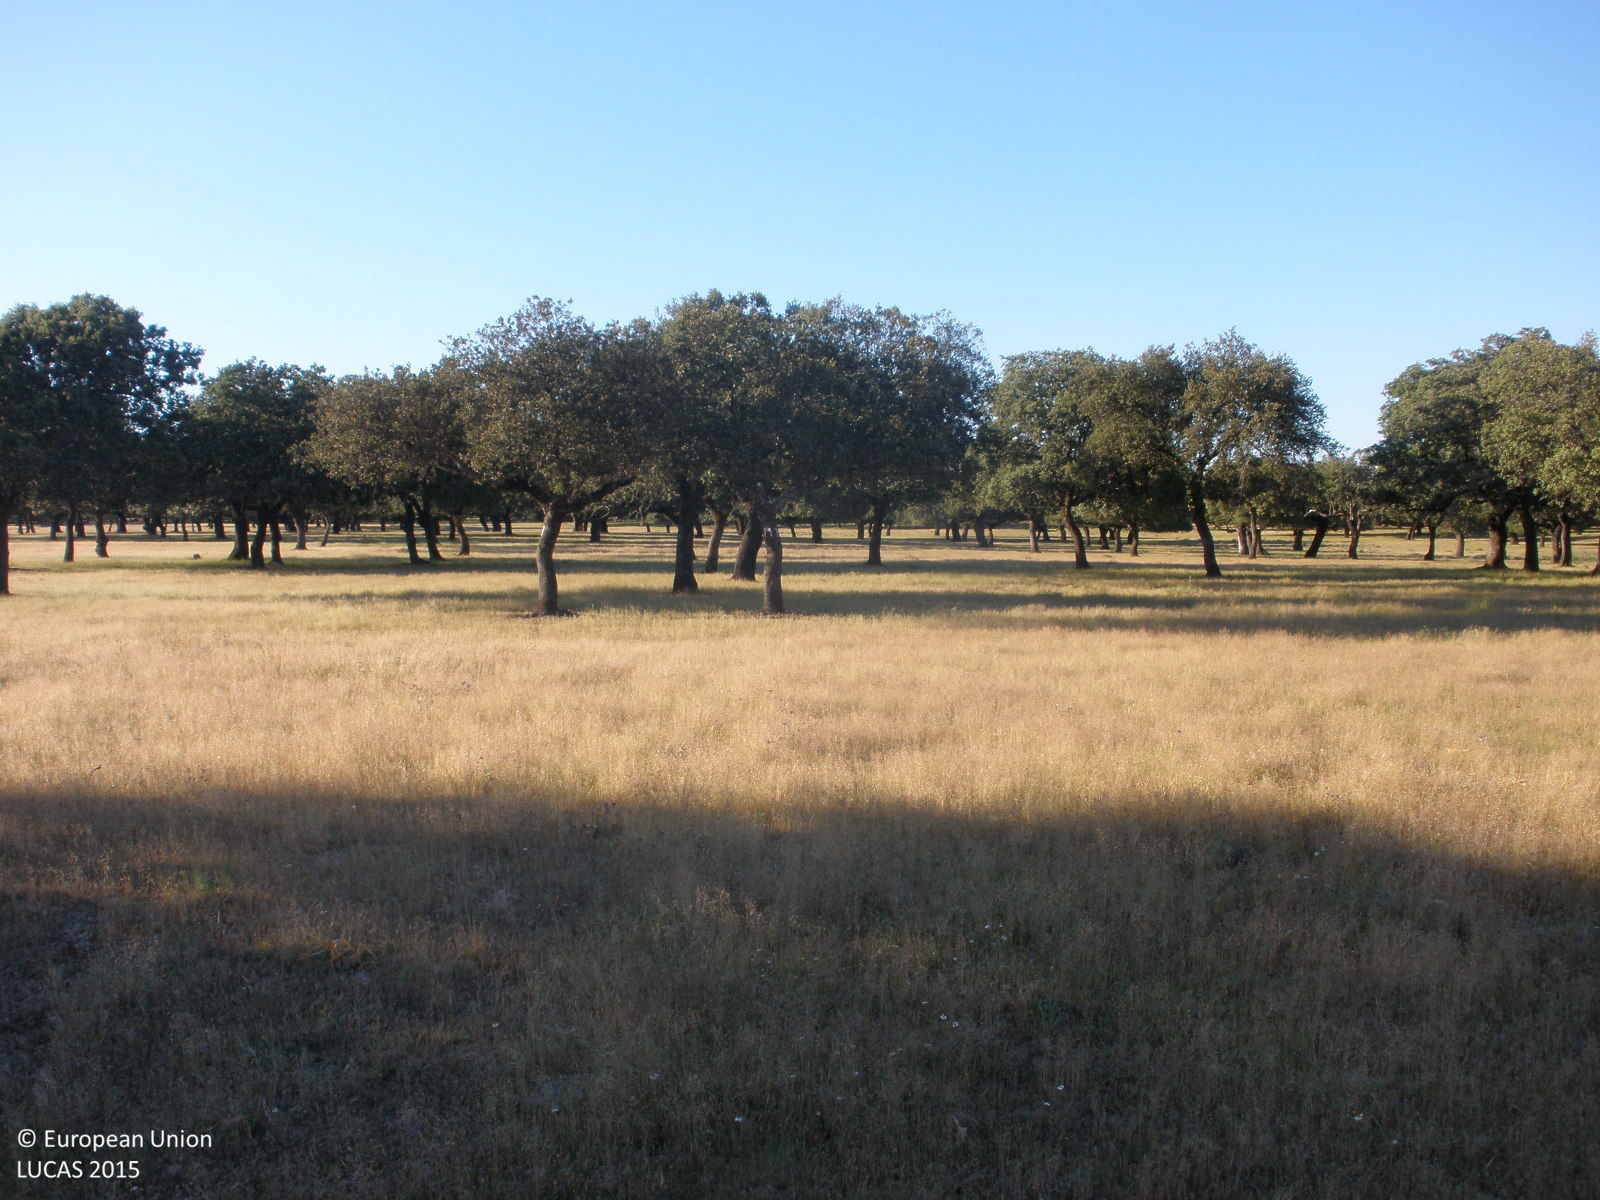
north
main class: Grassland
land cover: Grassland with sparse tree/shrub cover
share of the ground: > 75 %
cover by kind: herbaceous plants 95 %, broadleaved forest trees 5 %
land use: Agriculture (excluding fallow land and kitchen gardens)
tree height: > 5 m
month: May
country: ES
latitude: 40.2199
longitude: -6.1872
